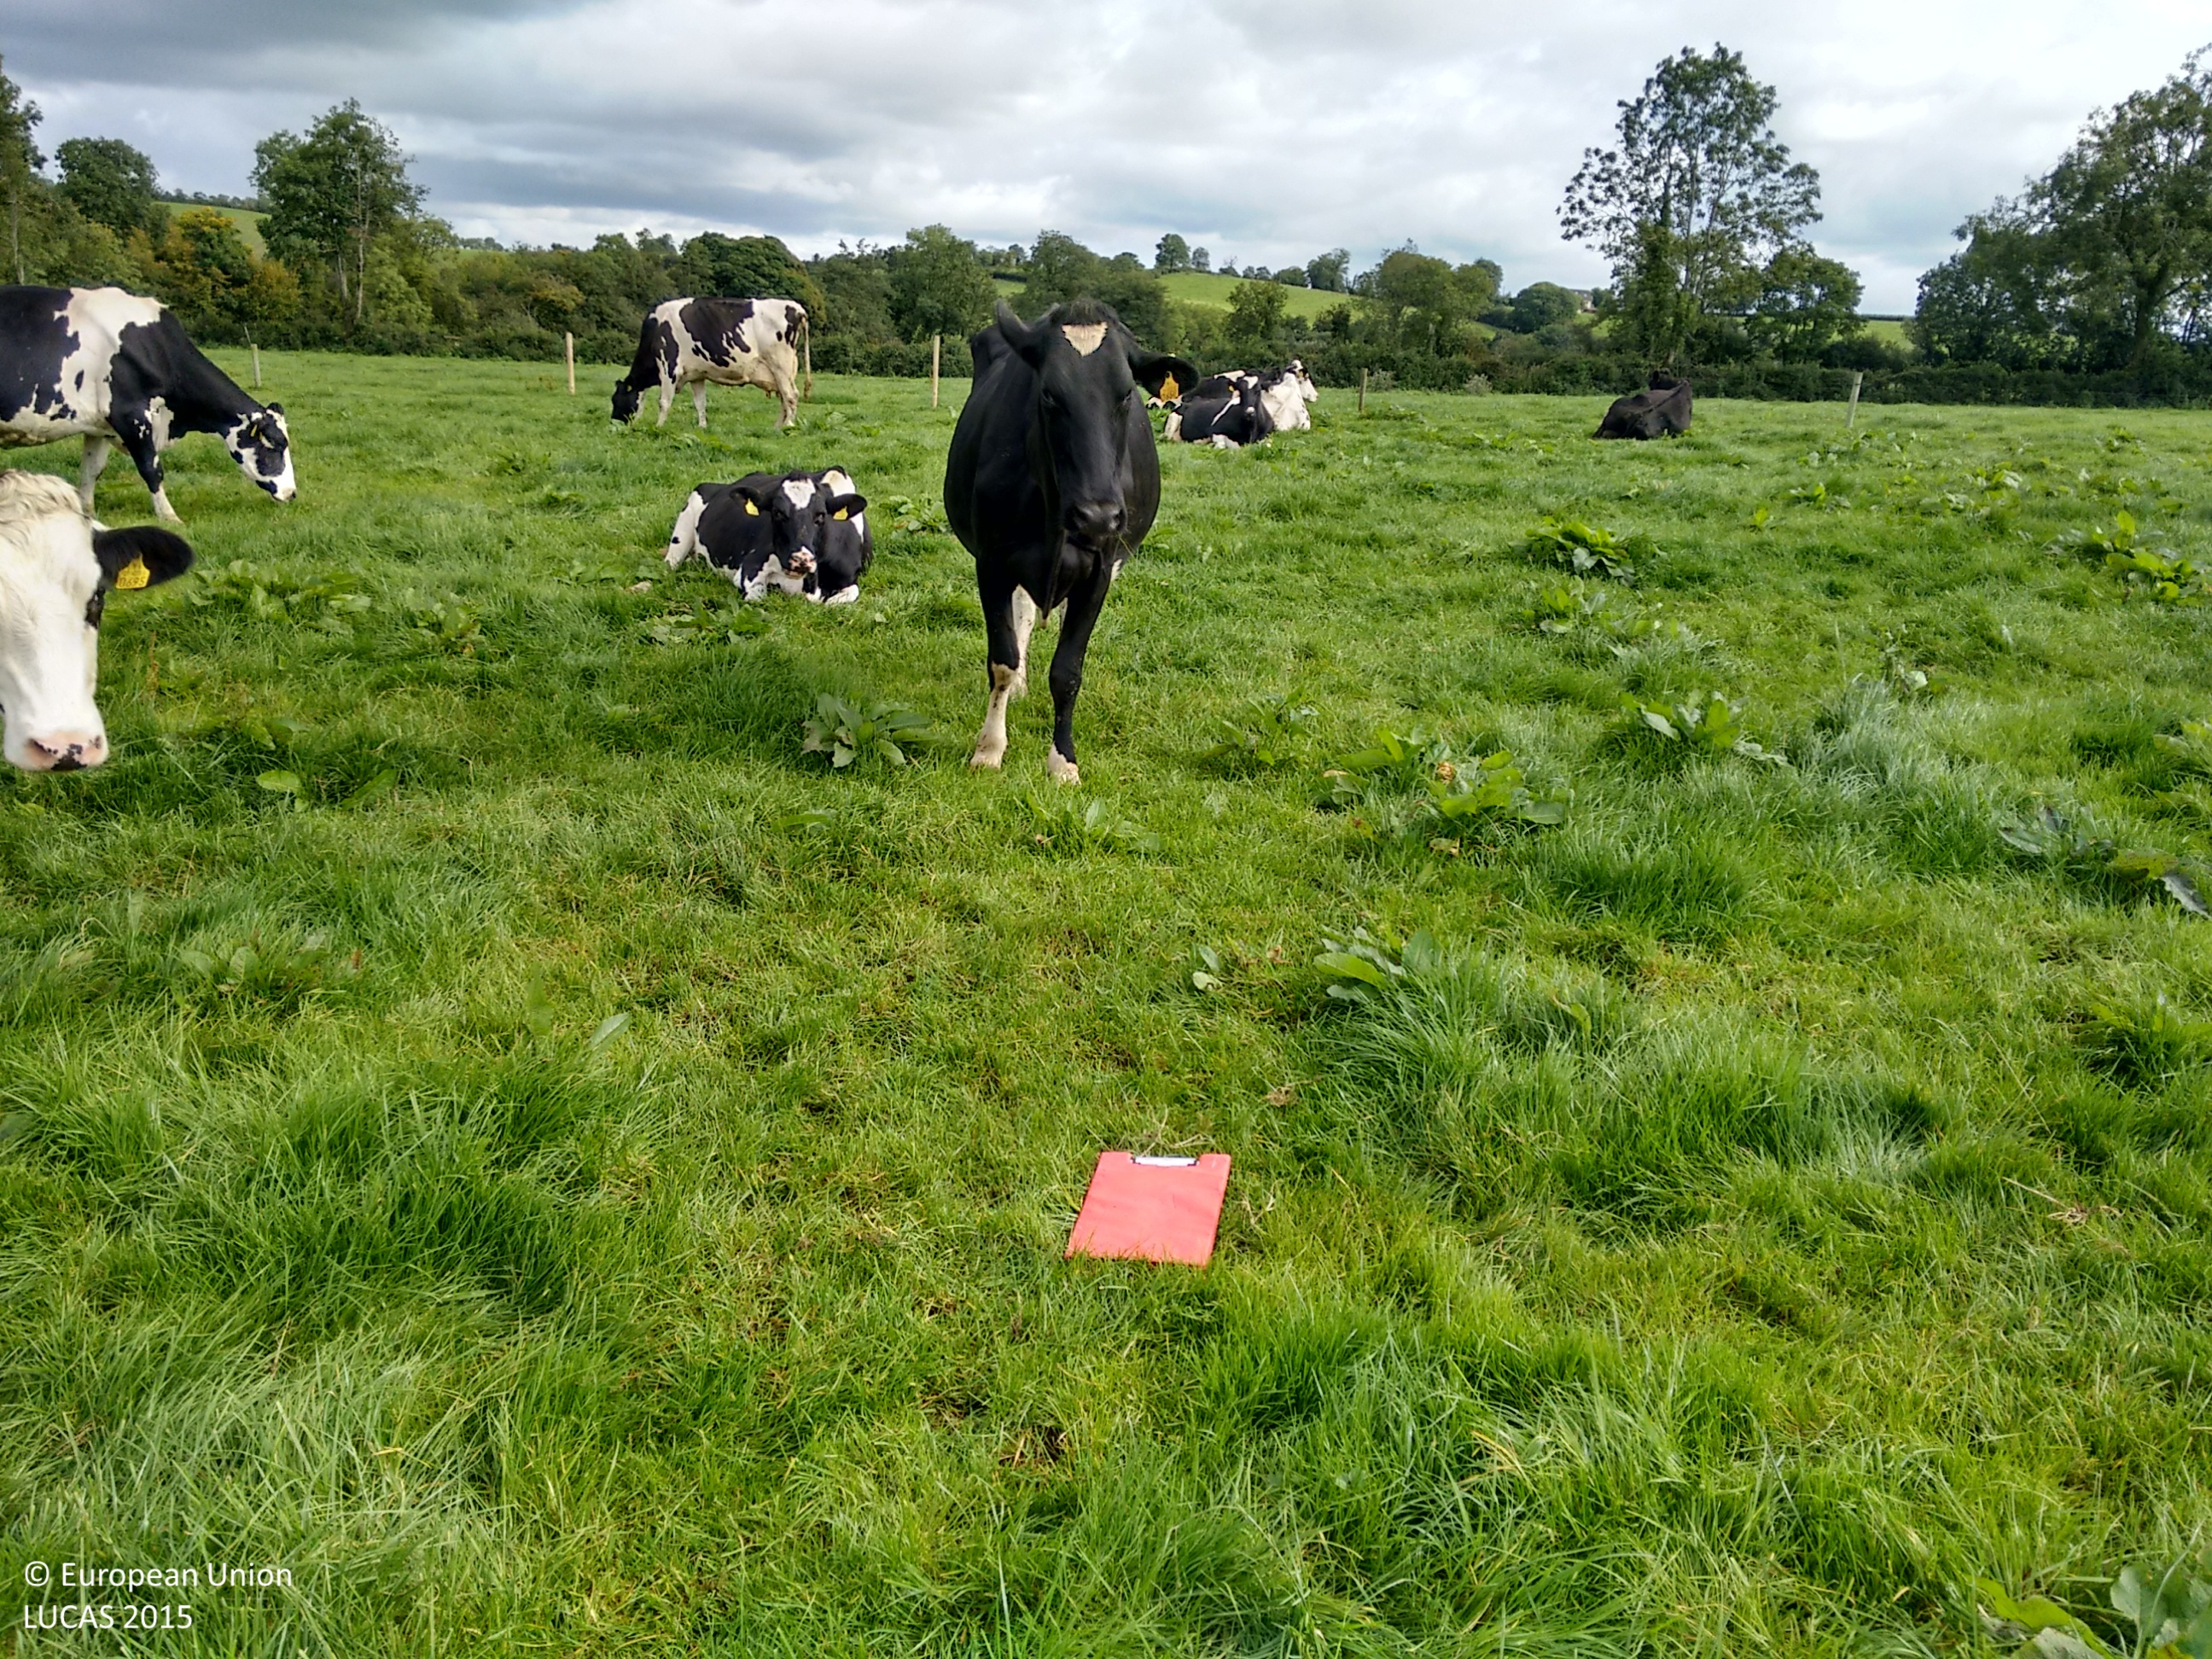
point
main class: Grassland
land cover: Grassland without tree/shrub cover
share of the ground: > 75 %
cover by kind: herbaceous plants 100 %
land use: Agriculture (excluding fallow land and kitchen gardens)
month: September
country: IE
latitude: 54.2906
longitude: -6.9613
